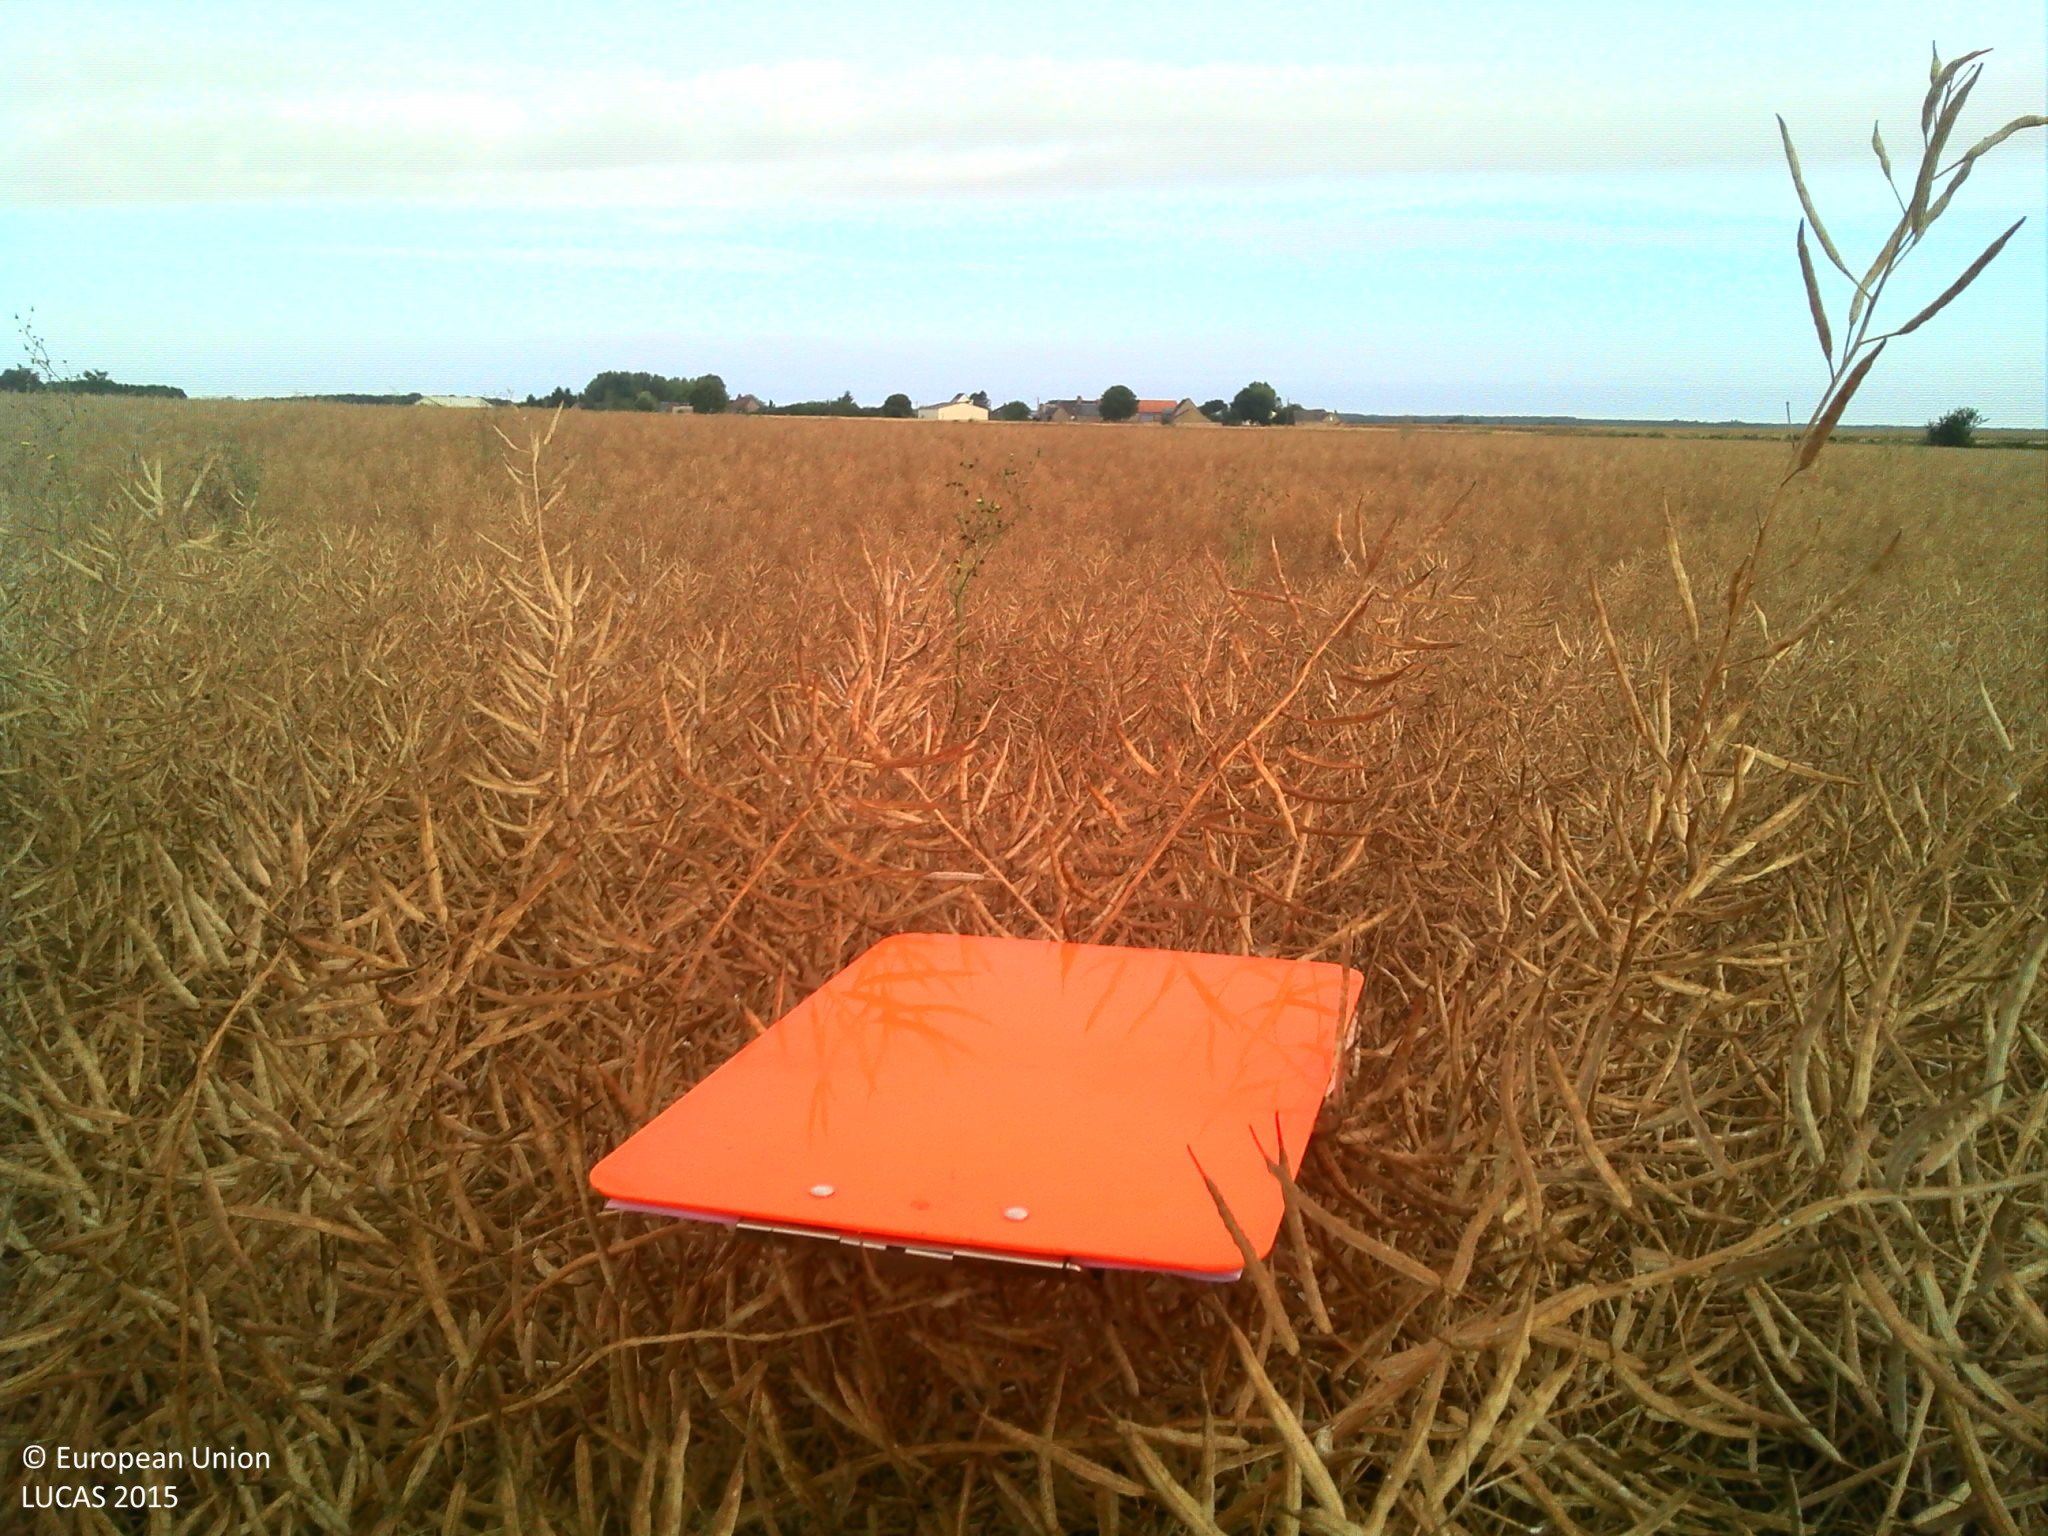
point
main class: Cropland
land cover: Rape and turnip rape
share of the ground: > 75 %
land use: Agriculture (excluding fallow land and kitchen gardens)
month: July
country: FR
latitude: 48.3101
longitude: 1.2581
